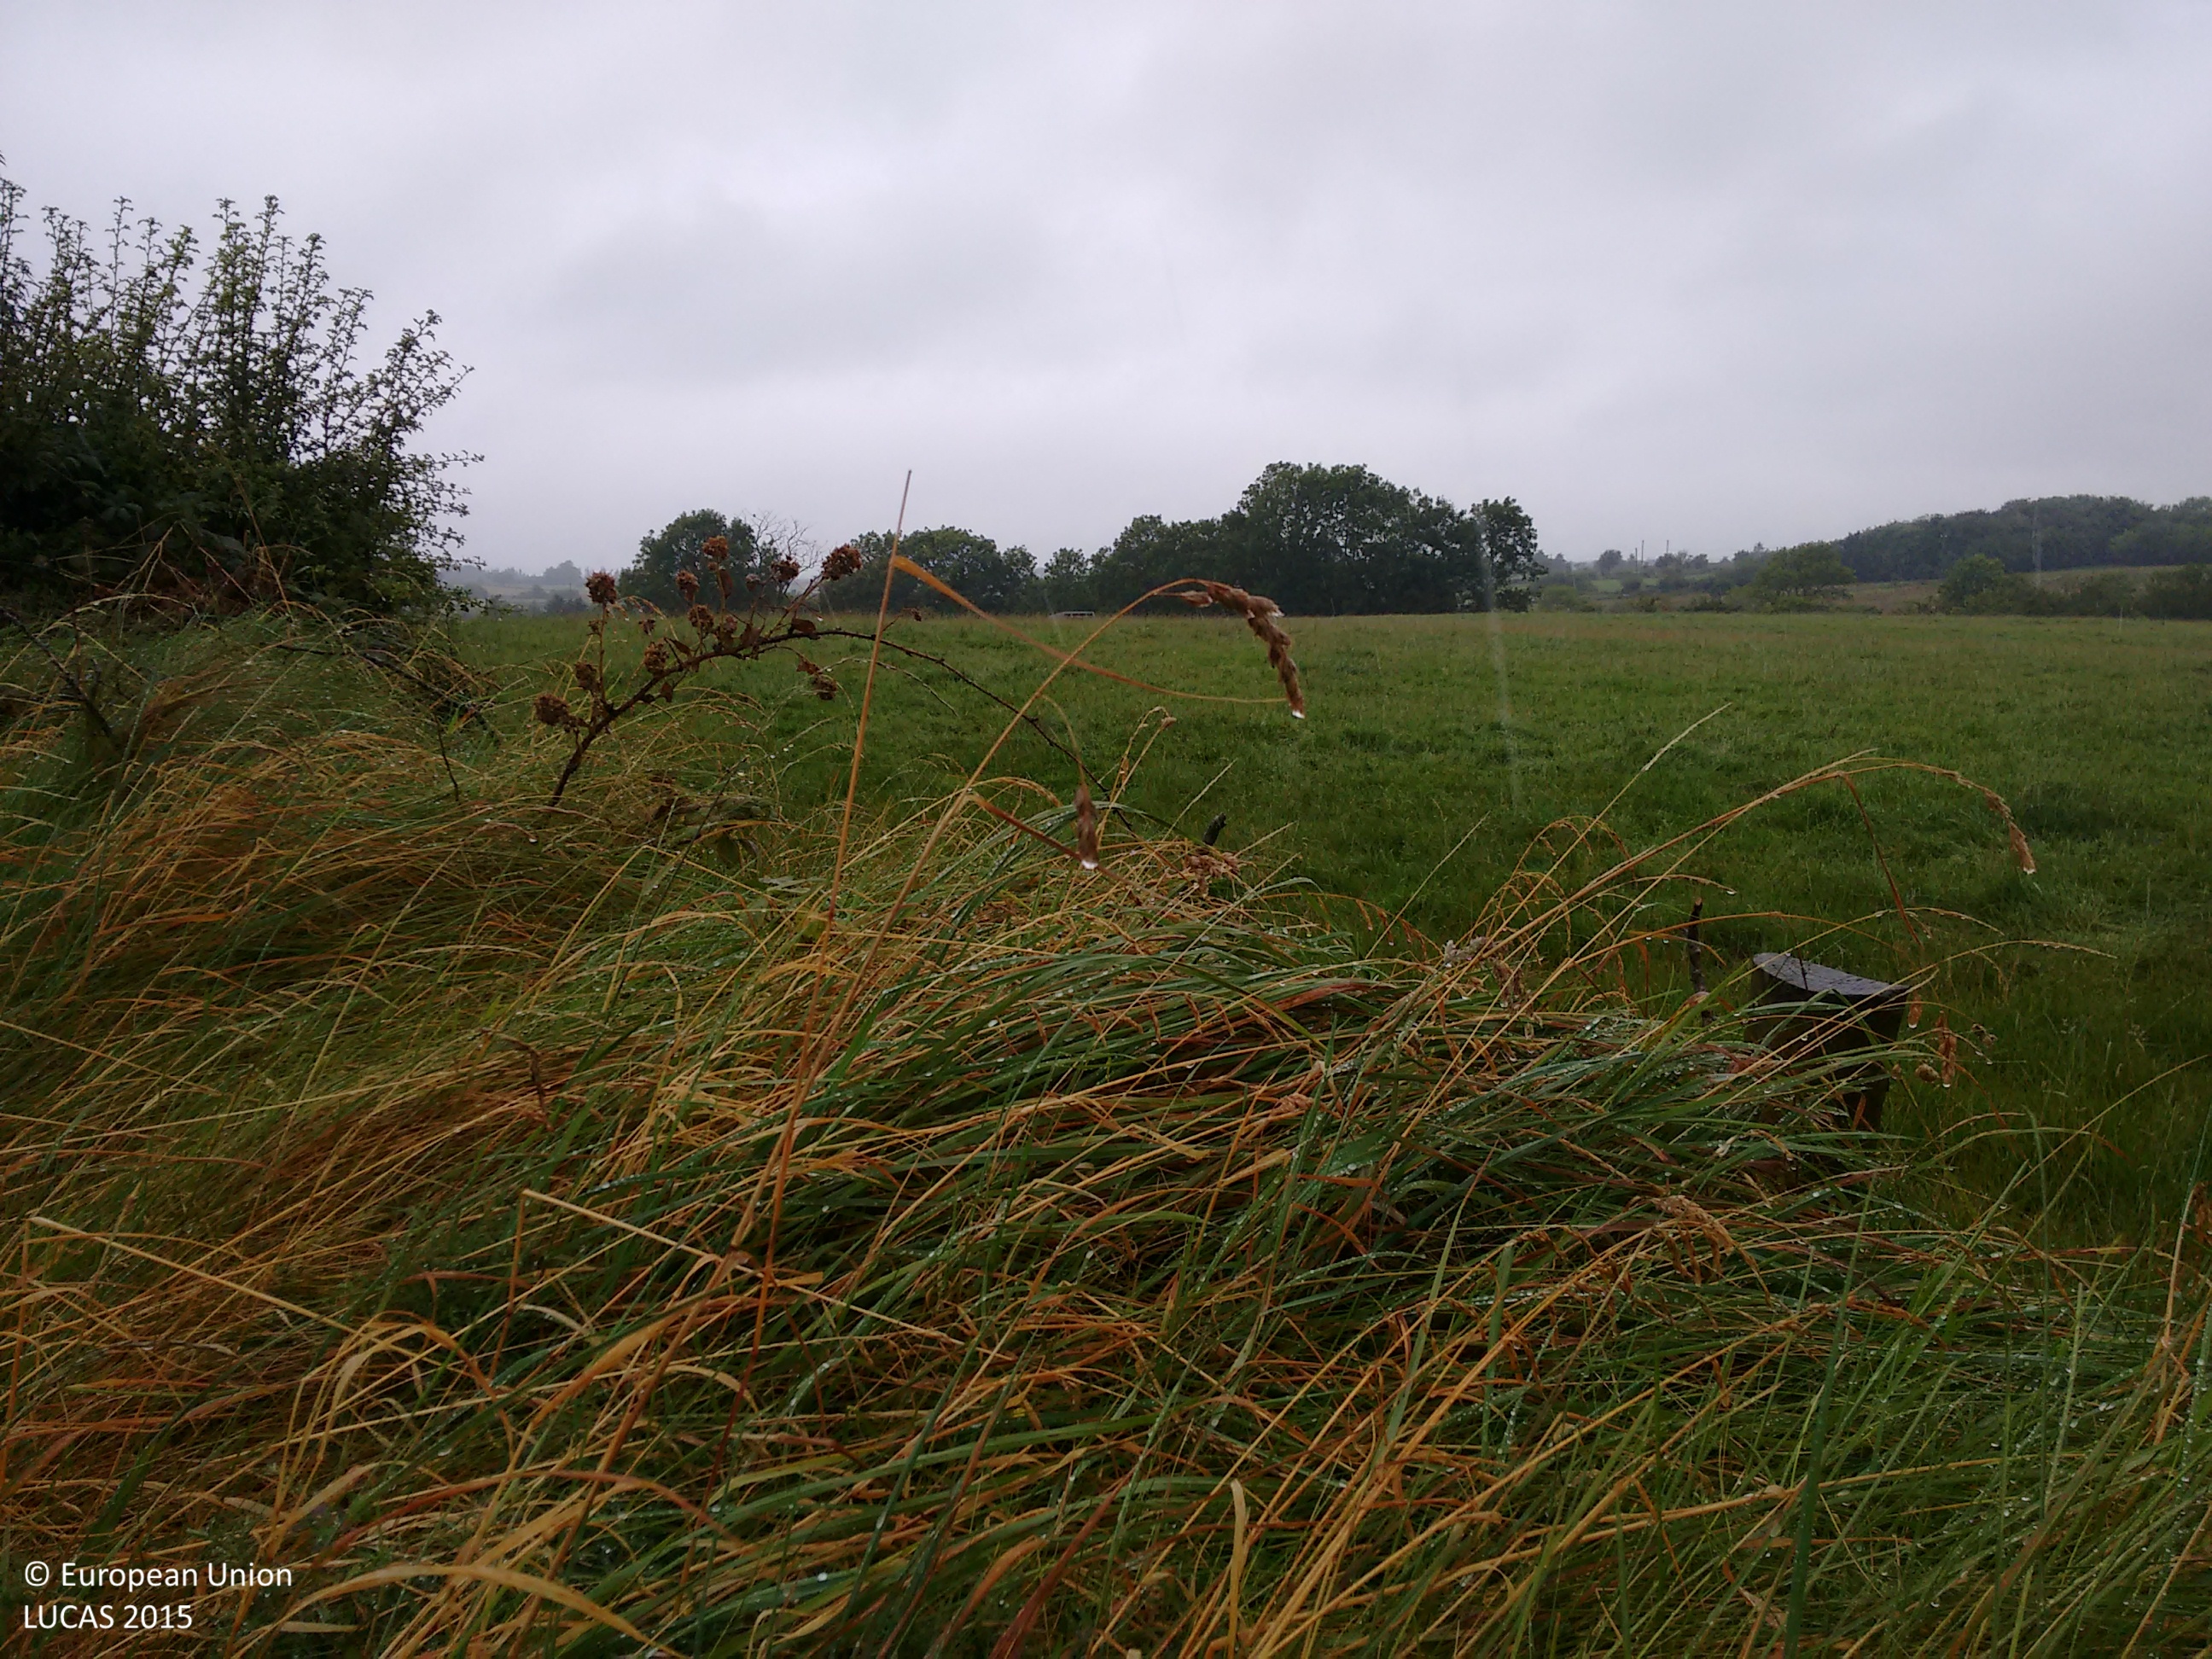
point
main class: Grassland
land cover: Grassland without tree/shrub cover
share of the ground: > 75 %
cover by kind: herbaceous plants 100 %
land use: Agriculture (excluding fallow land and kitchen gardens)
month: September
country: IE
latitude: 54.1489
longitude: -9.3798
